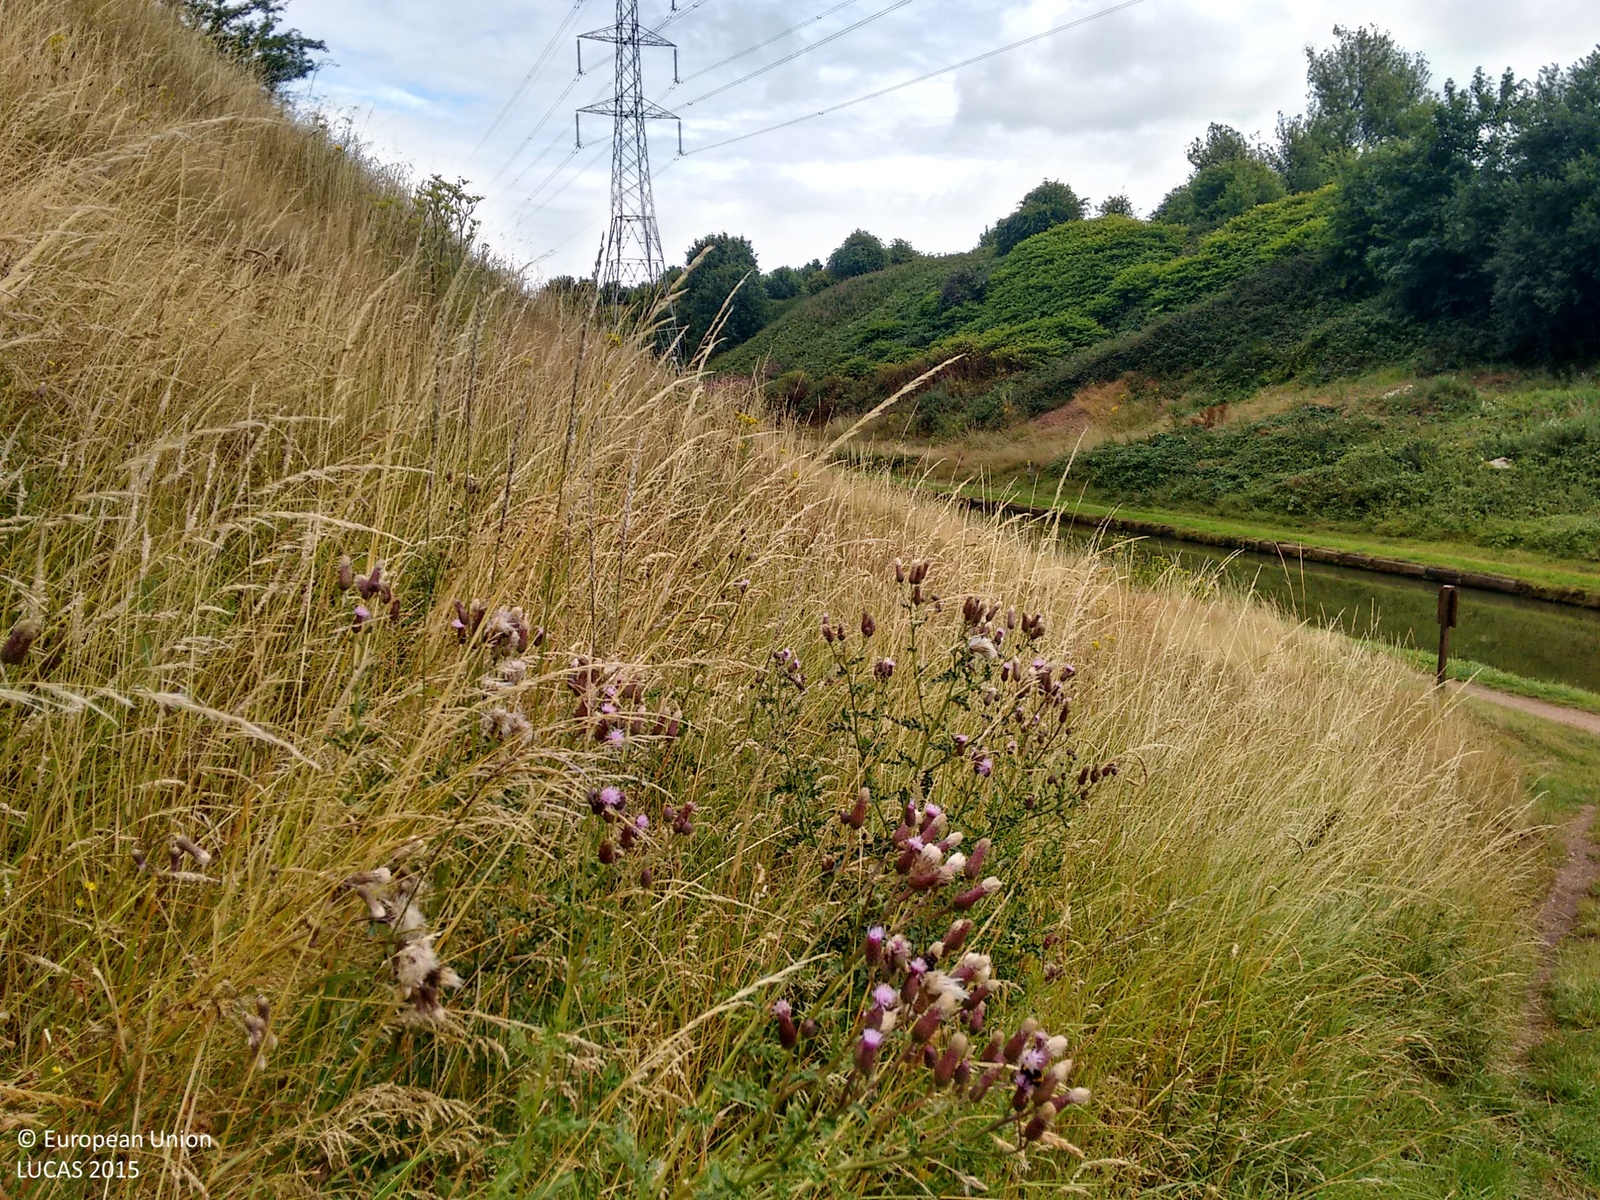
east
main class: Grassland
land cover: Grassland without tree/shrub cover
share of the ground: > 75 %
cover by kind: herbaceous plants 100 %
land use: Water transport
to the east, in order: Grassland without tree/shrub cover; Tracks; Grass margins; Inland fresh running water; Grass margins; Spontaneously vegetated surfaces; Electric lines; Spontaneously vegetated surfaces; Broadleaved woodland; Fences; Broadleaved woodland
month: July
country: GB
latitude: 52.5491
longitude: -1.9886
